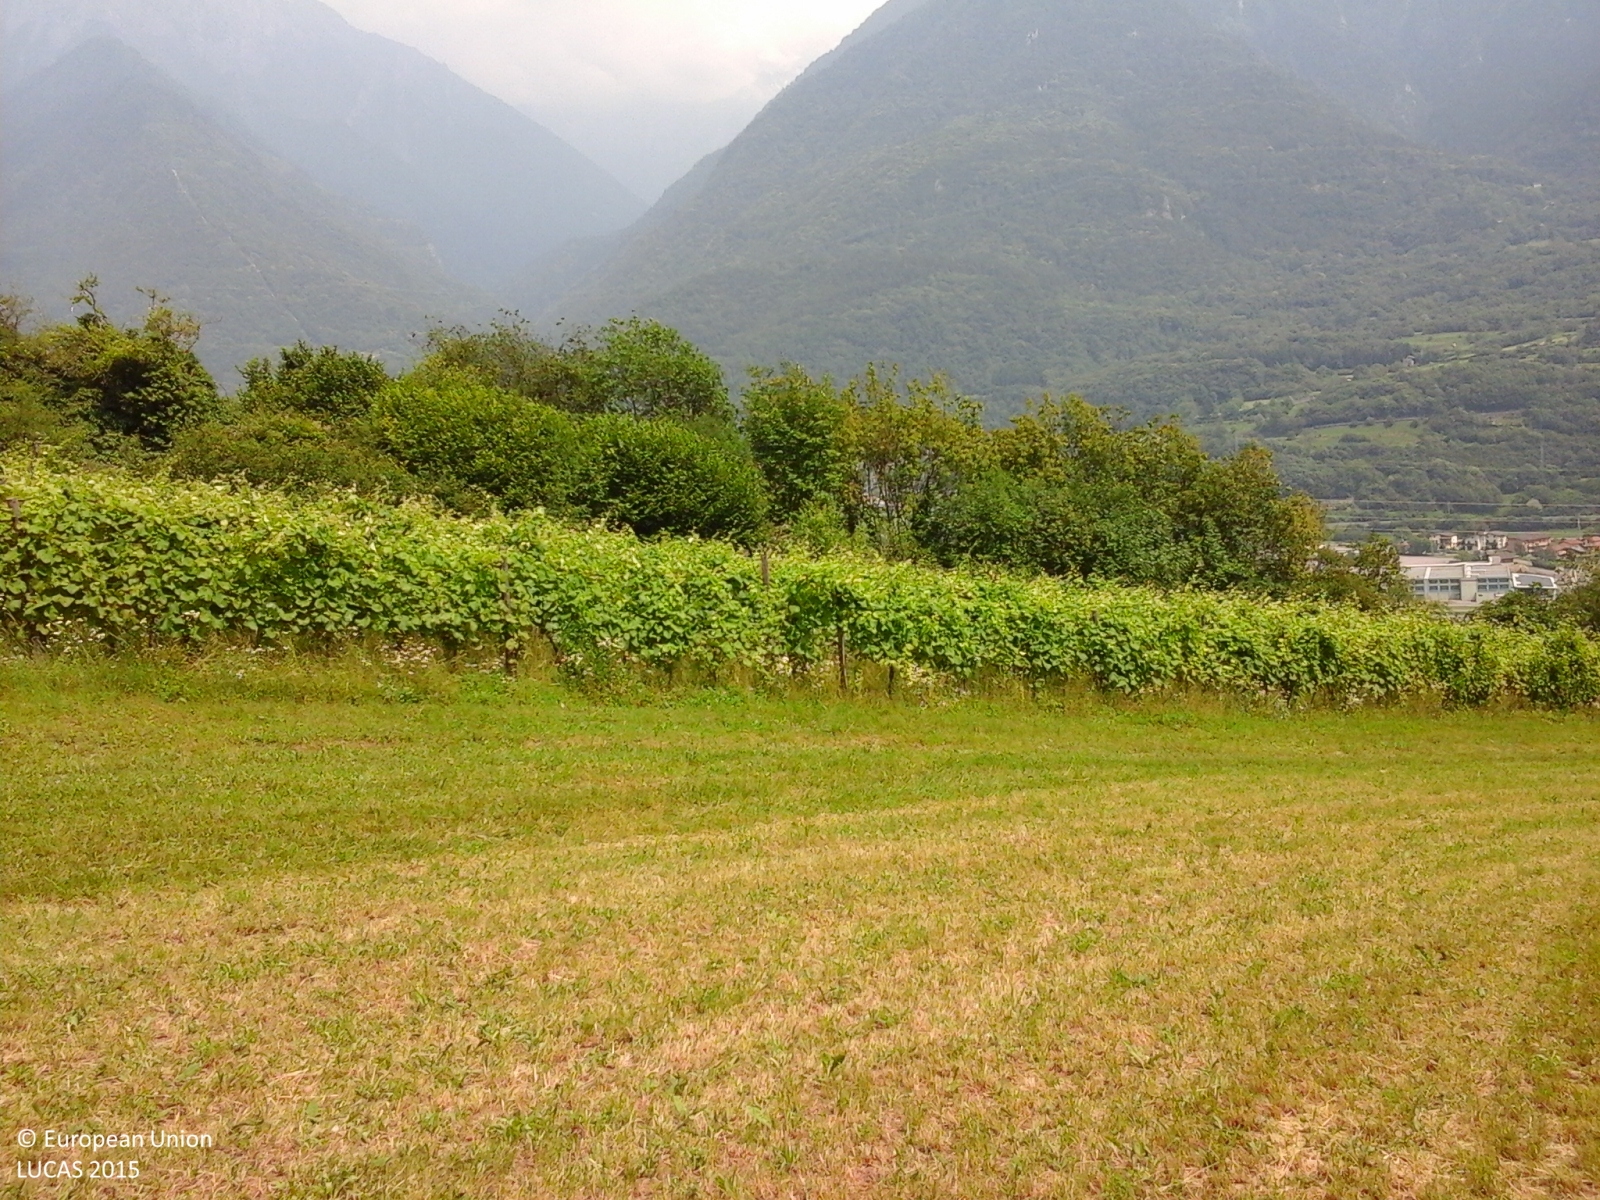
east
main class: Grassland
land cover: Grassland without tree/shrub cover
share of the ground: > 75 %
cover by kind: herbaceous plants 100 %
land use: Agriculture (excluding fallow land and kitchen gardens)
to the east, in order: Grassland without tree/shrub cover; Vineyards; Grass margins; Broadleaved woodland; Artificial constructions in urban areas; Grassland without tree/shrub cover; Dry stone walls; Broadleaved woodland; Spontaneously vegetated surfaces; Dry stone walls; Spontaneously vegetated surfaces; Maize; Grassland without tree/shrub cover; Dry stone walls; Paved roads, cycling and walking lanes; Electric lines; Grassland without tree/shrub cover; Dry stone walls; Tracks; Broadleaved woodland
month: July
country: IT
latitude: 45.9904
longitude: 10.3223
